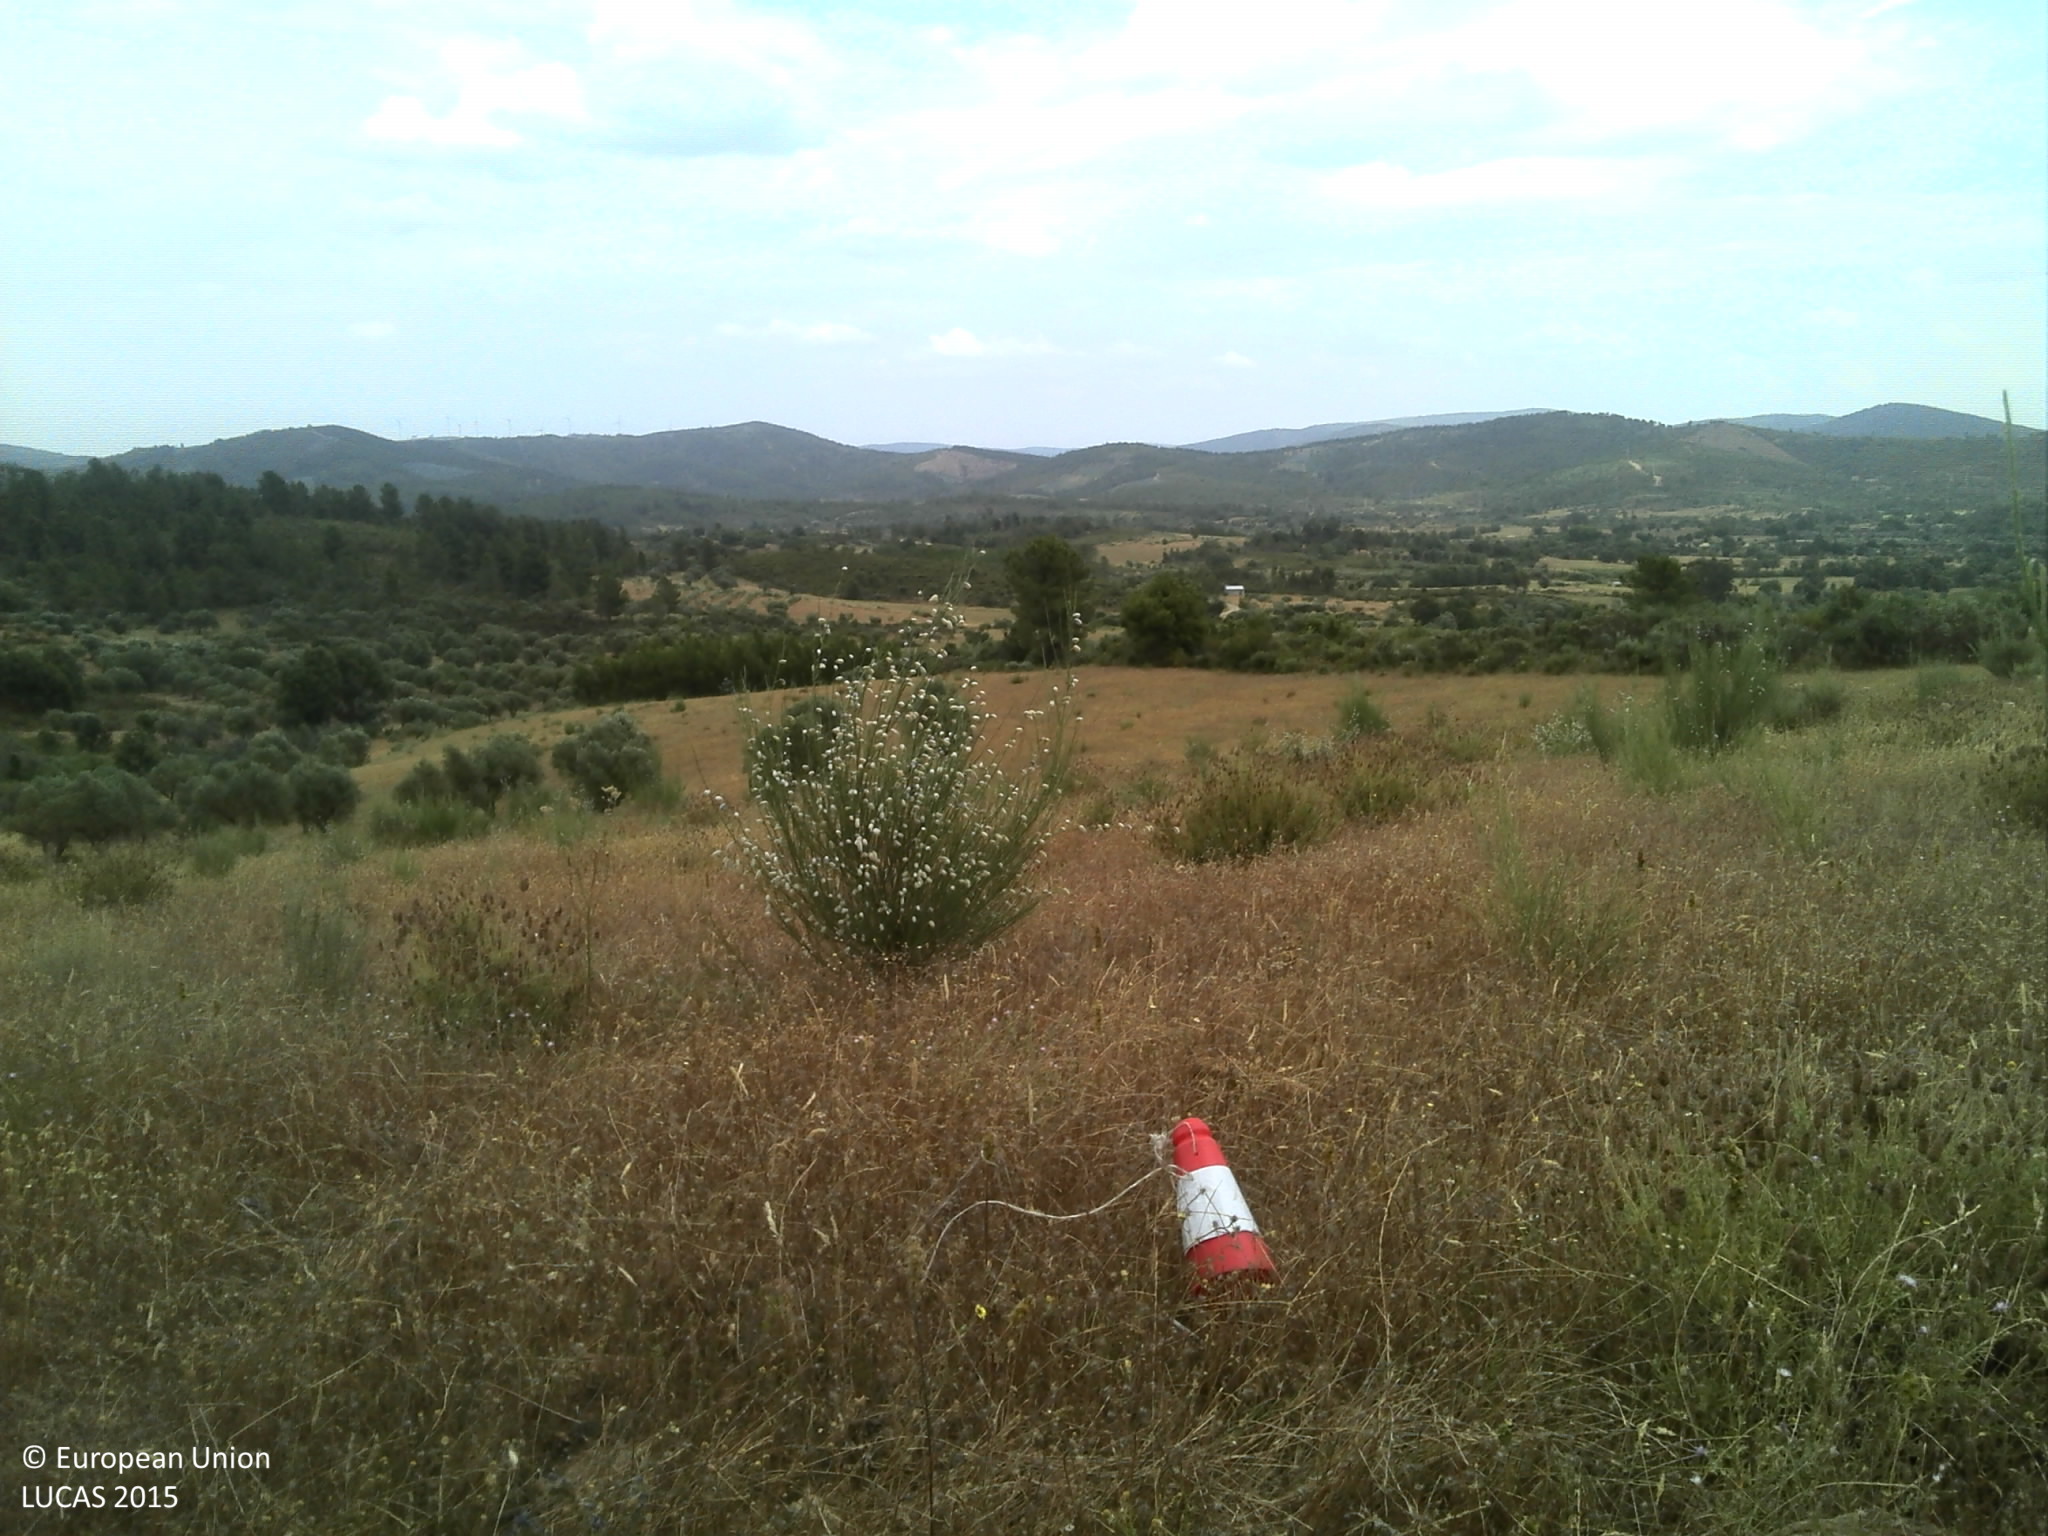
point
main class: Grassland
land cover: Grassland without tree/shrub cover
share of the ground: 50 - 75 %
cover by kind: herbaceous plants 65 %, unconsolidated bare surface 25 %, shrubs 5 %
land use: Agriculture (excluding fallow land and kitchen gardens)
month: June
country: PT
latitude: 40.2607
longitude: -7.2319
